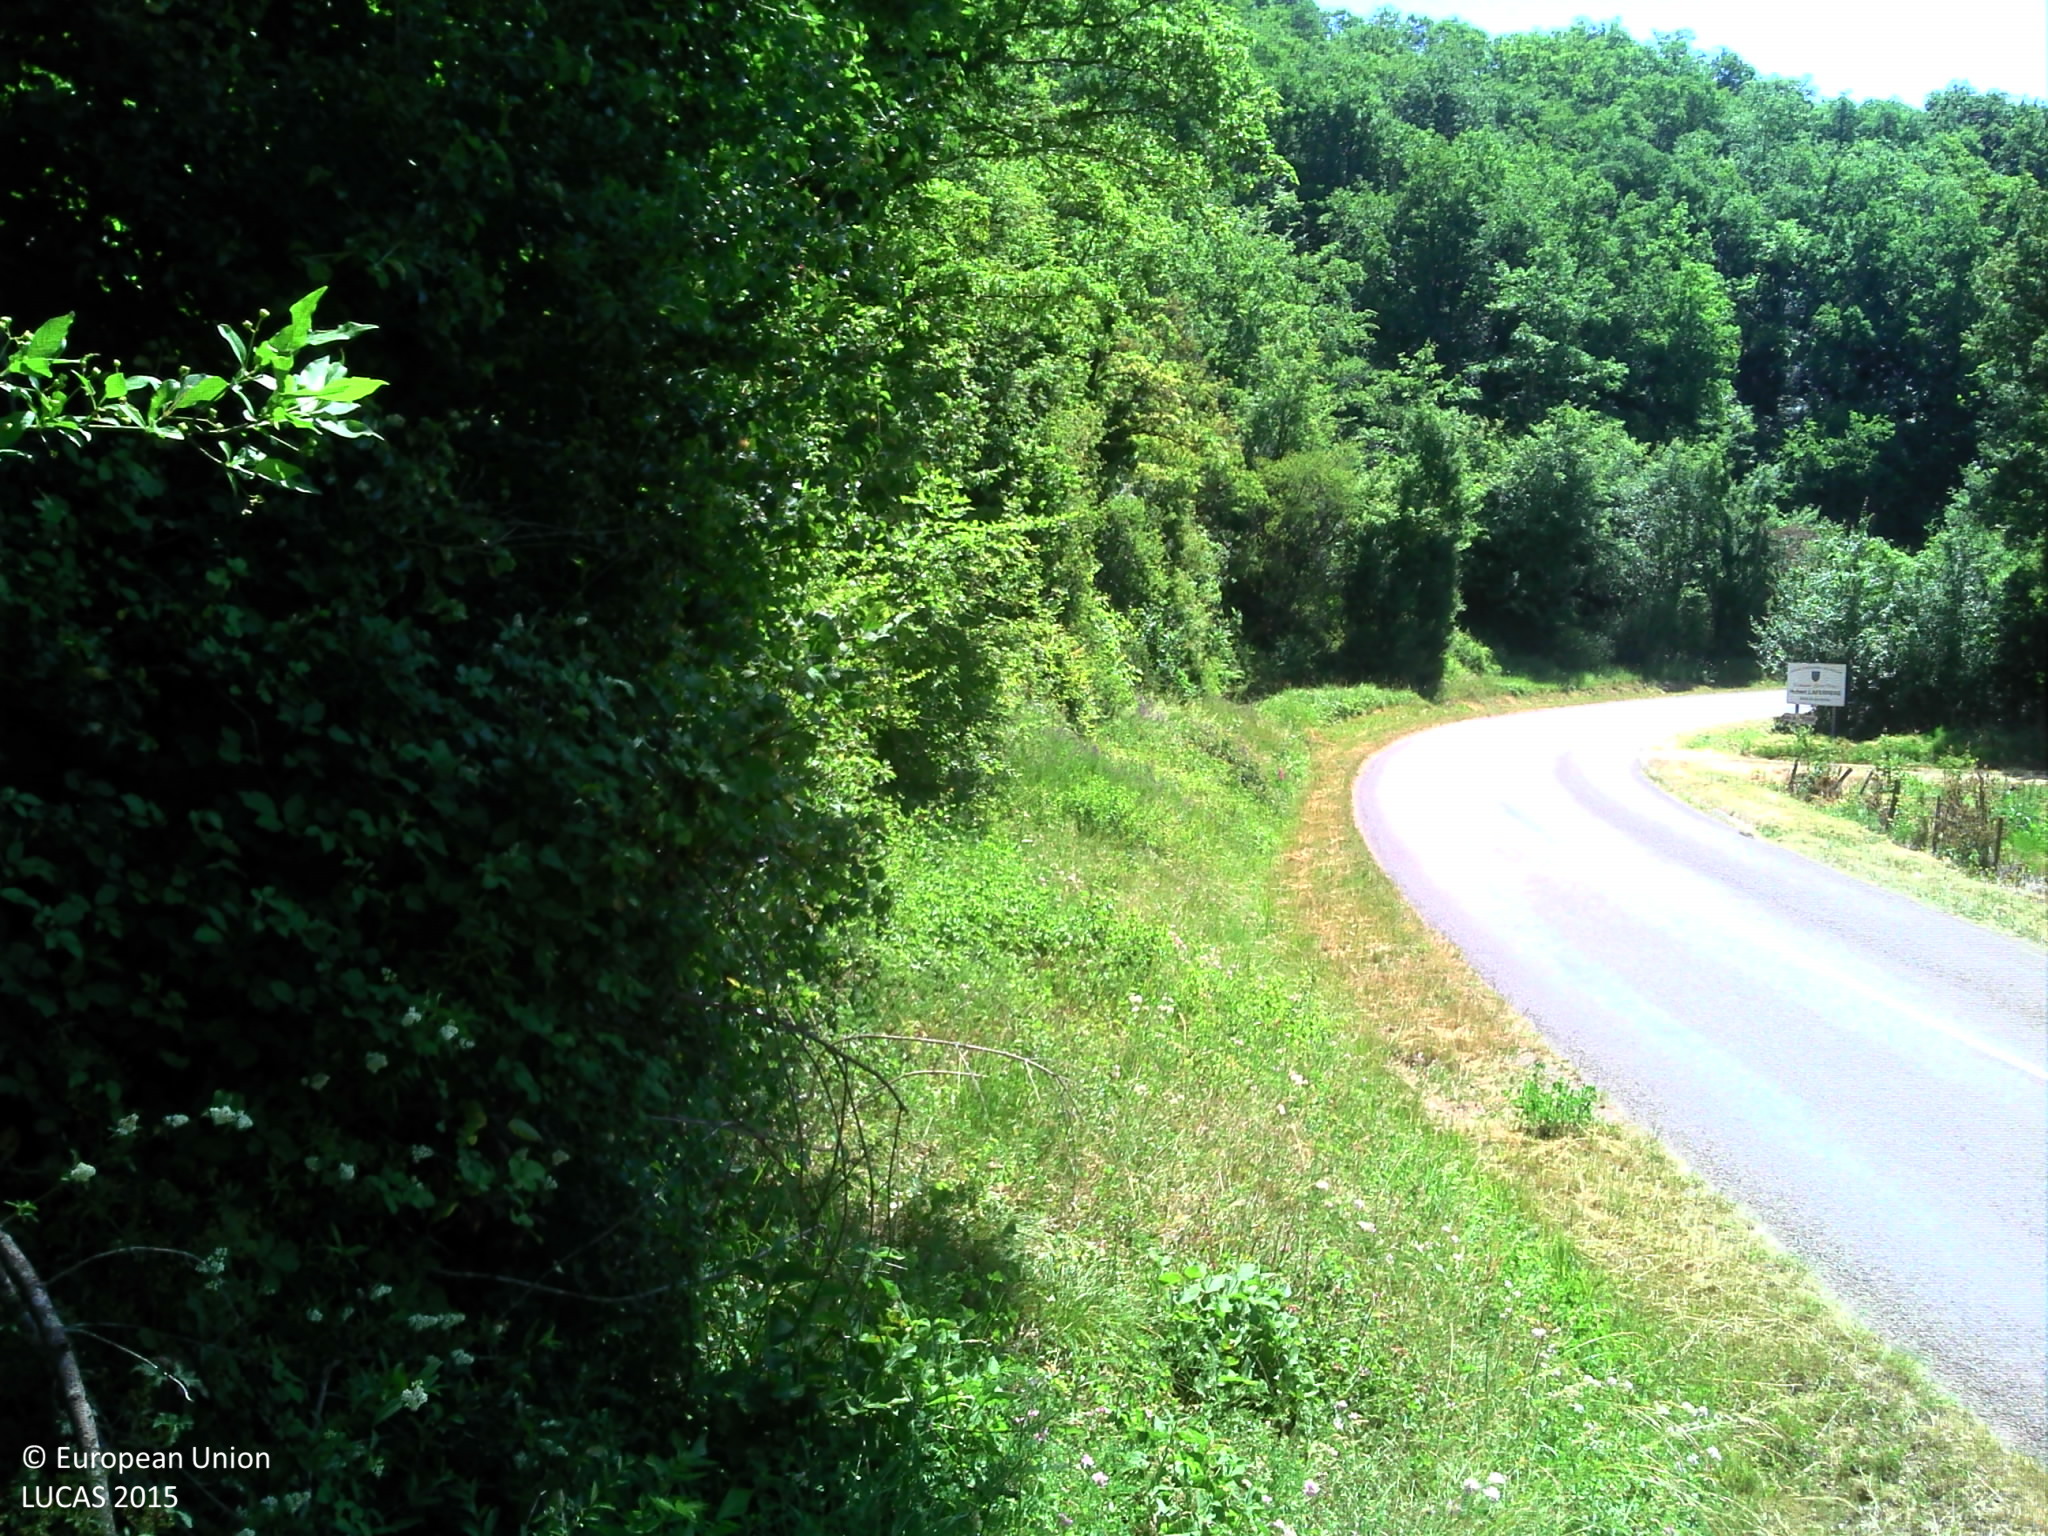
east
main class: Woodland
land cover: Broadleaved woodland
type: mesophytic deciduous forest
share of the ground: > 75 %
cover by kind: broadleaved forest trees 85 %, herbaceous plants 15 %
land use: Forestry
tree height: > 5 m
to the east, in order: Broadleaved woodland; Grass margins; Tracks; Vineyards; Dry stone walls; Broadleaved woodland; Tracks; Grass margins; Spontaneously vegetated surfaces
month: June
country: FR
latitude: 46.4776
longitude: 4.8049
